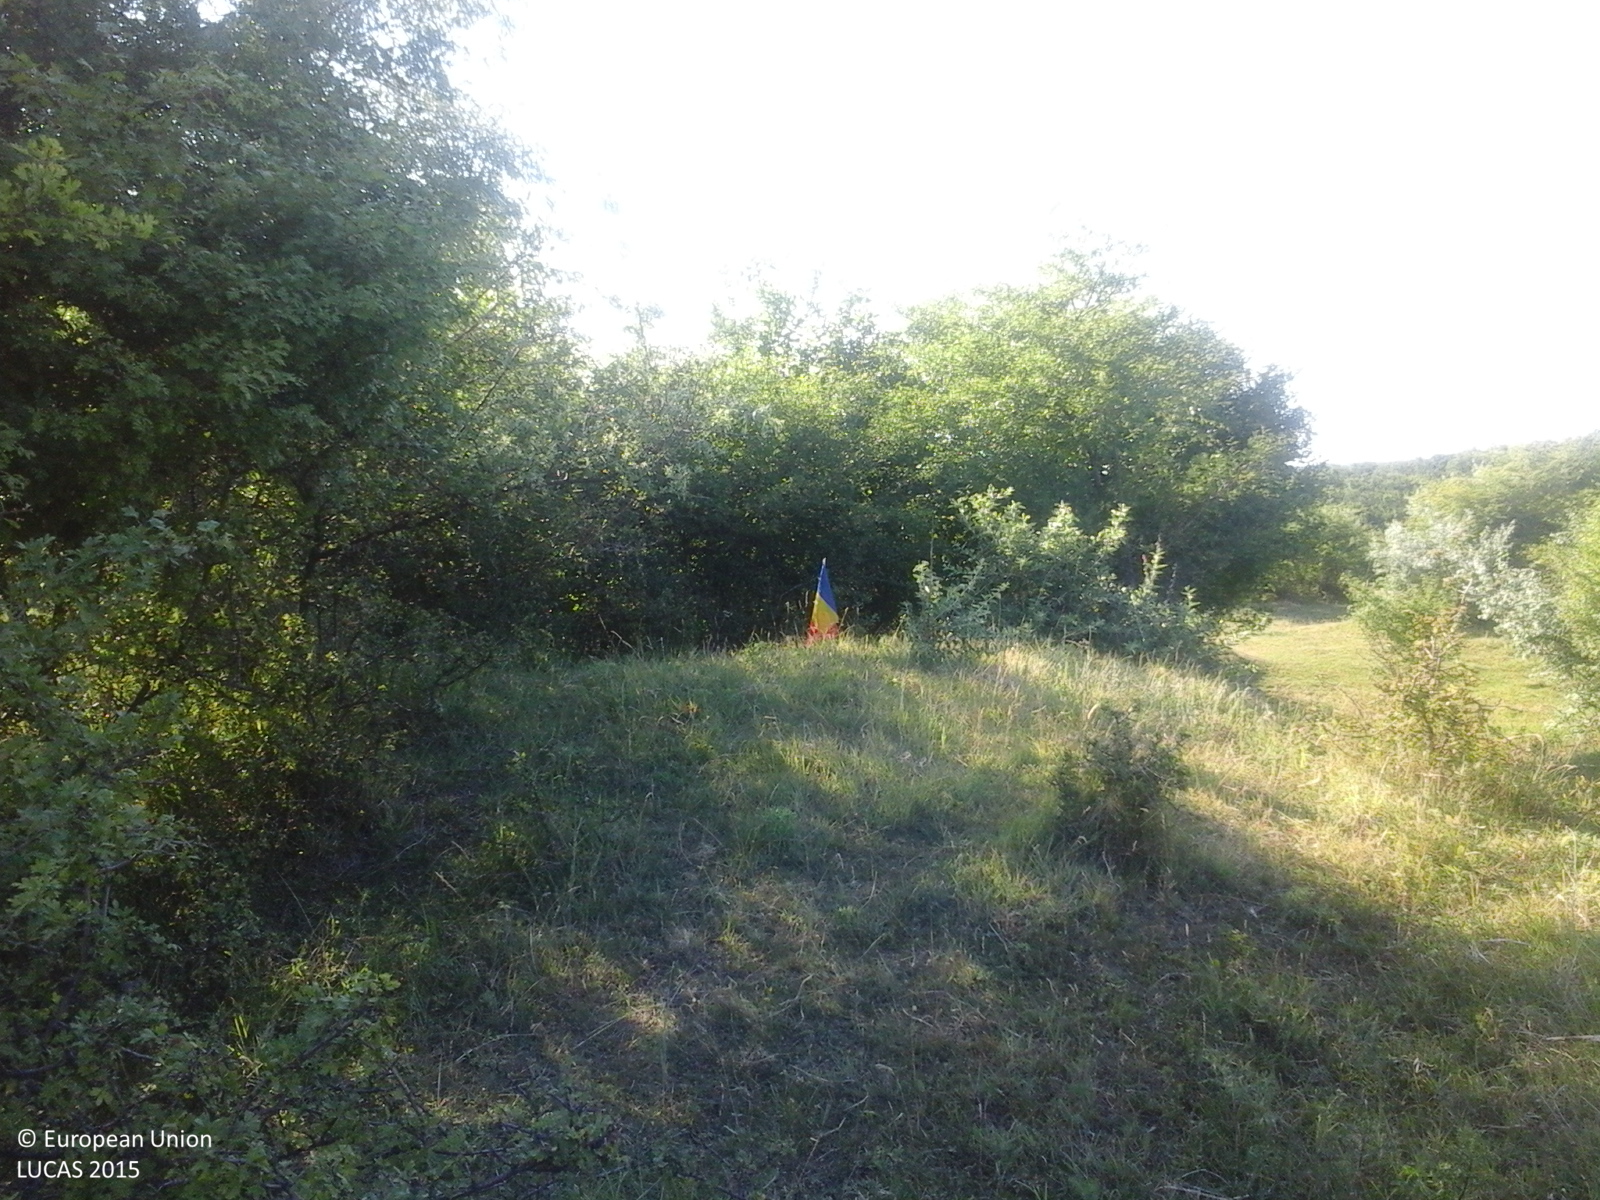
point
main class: Shrubland
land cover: Shrubland with sparse tree cover
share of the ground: > 75 %
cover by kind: herbaceous plants 85 %, shrubs 10 %, broadleaved forest trees 5 %
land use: Agriculture (excluding fallow land and kitchen gardens)
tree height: < 5 m
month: June
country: RO
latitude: 46.9990
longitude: 27.3509
